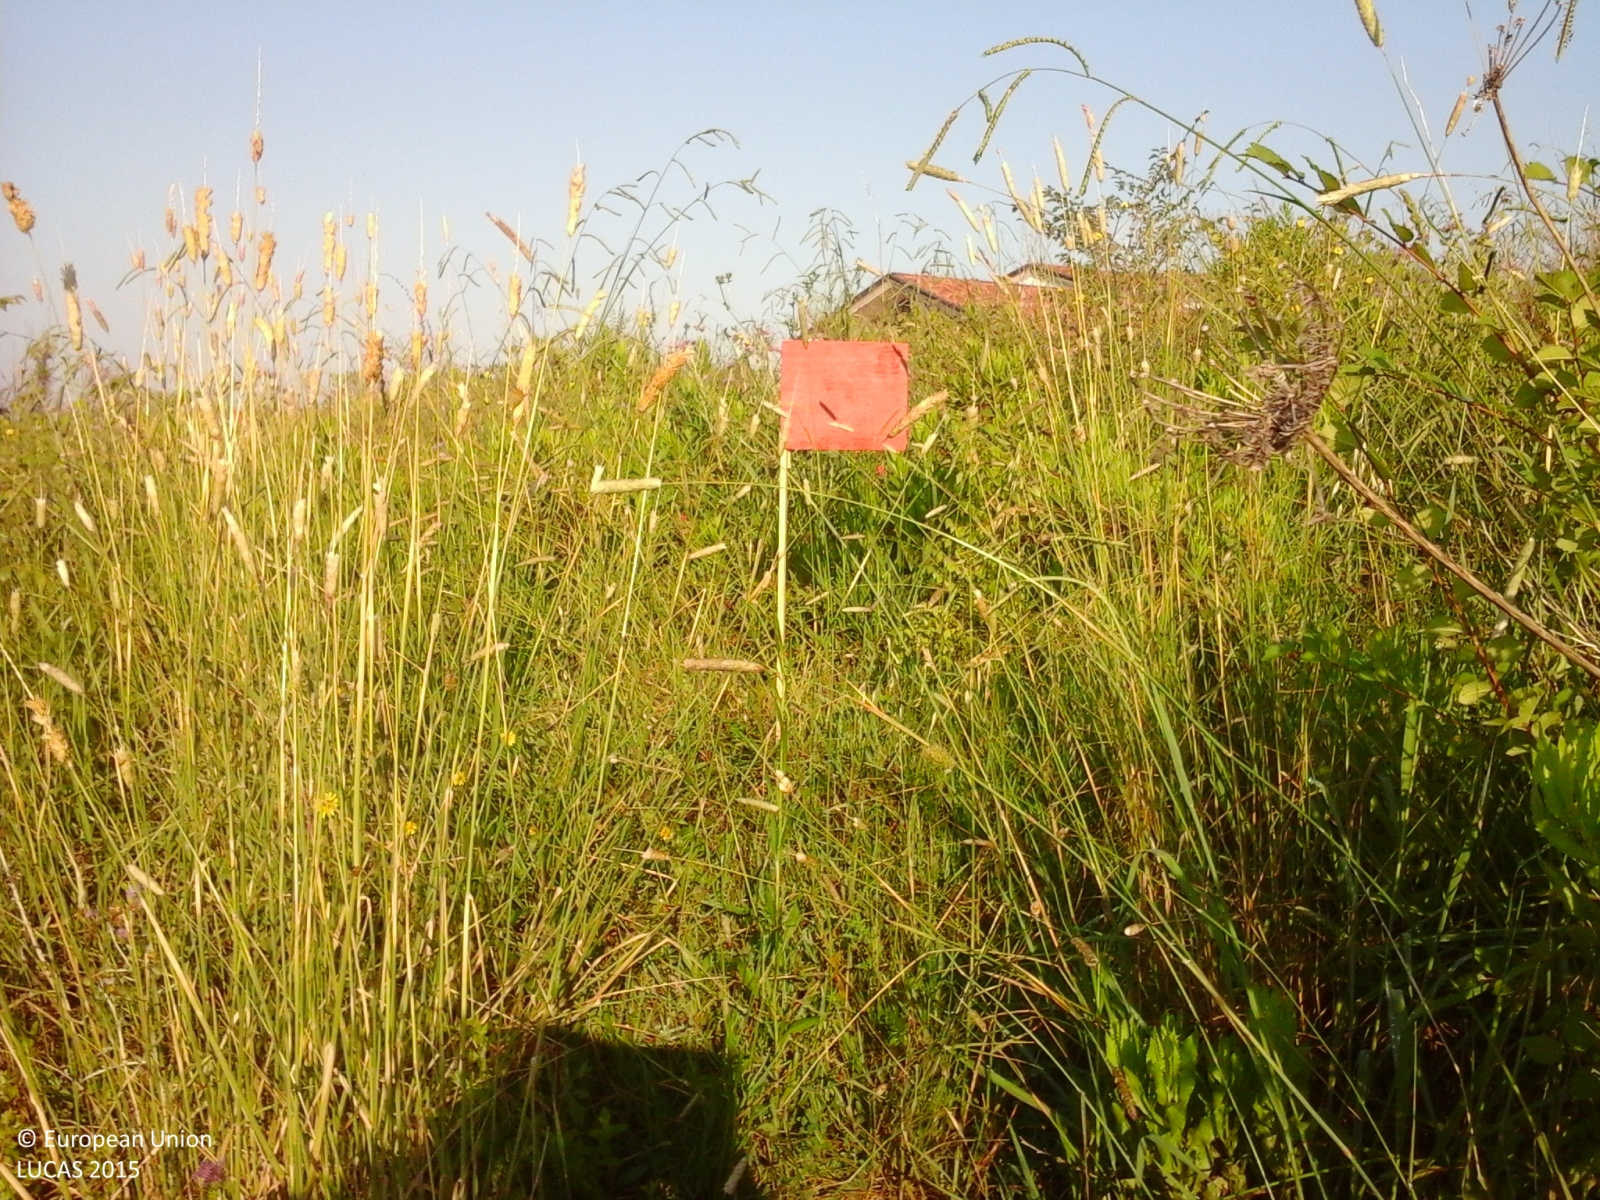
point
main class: Grassland
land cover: Grassland without tree/shrub cover
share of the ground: > 75 %
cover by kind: herbaceous plants 100 %
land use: Abandoned areas
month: June
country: IT
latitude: 40.6507
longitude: 14.9347
